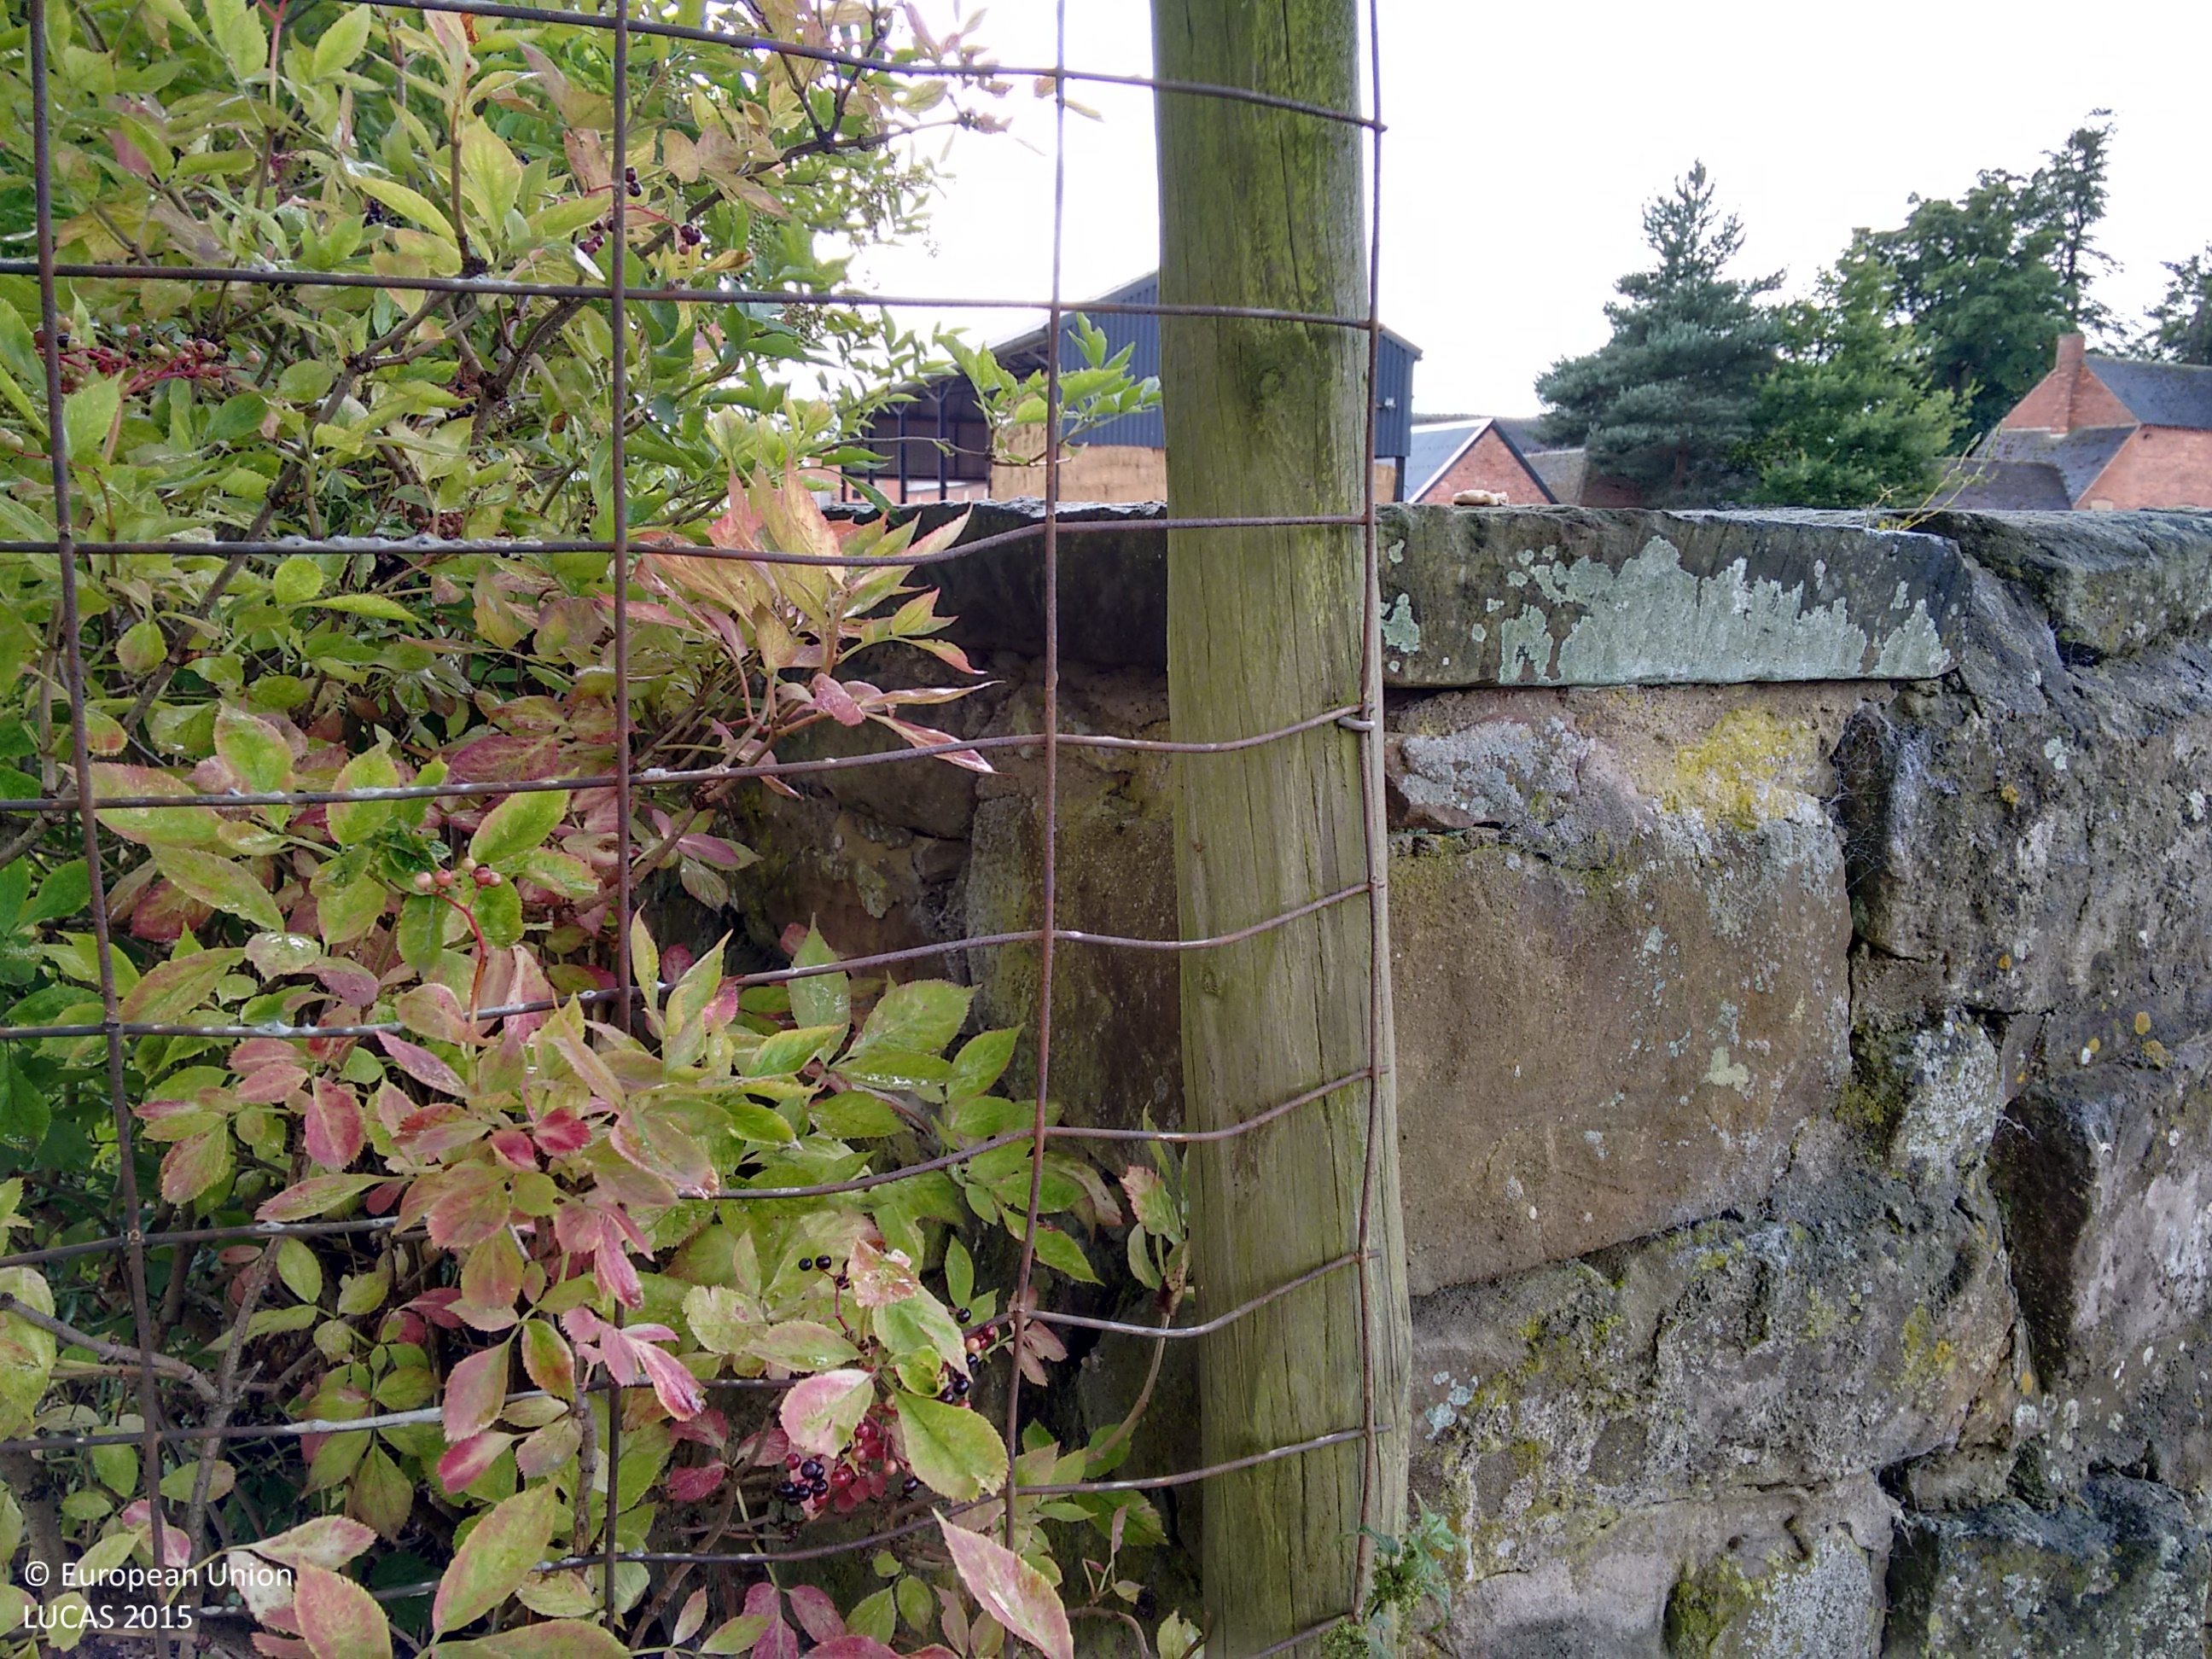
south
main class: Grassland
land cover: Grassland without tree/shrub cover
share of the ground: > 75 %
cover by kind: herbaceous plants 100 %
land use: Agriculture (excluding fallow land and kitchen gardens)
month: September
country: GB
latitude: 52.8017
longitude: -1.4564
